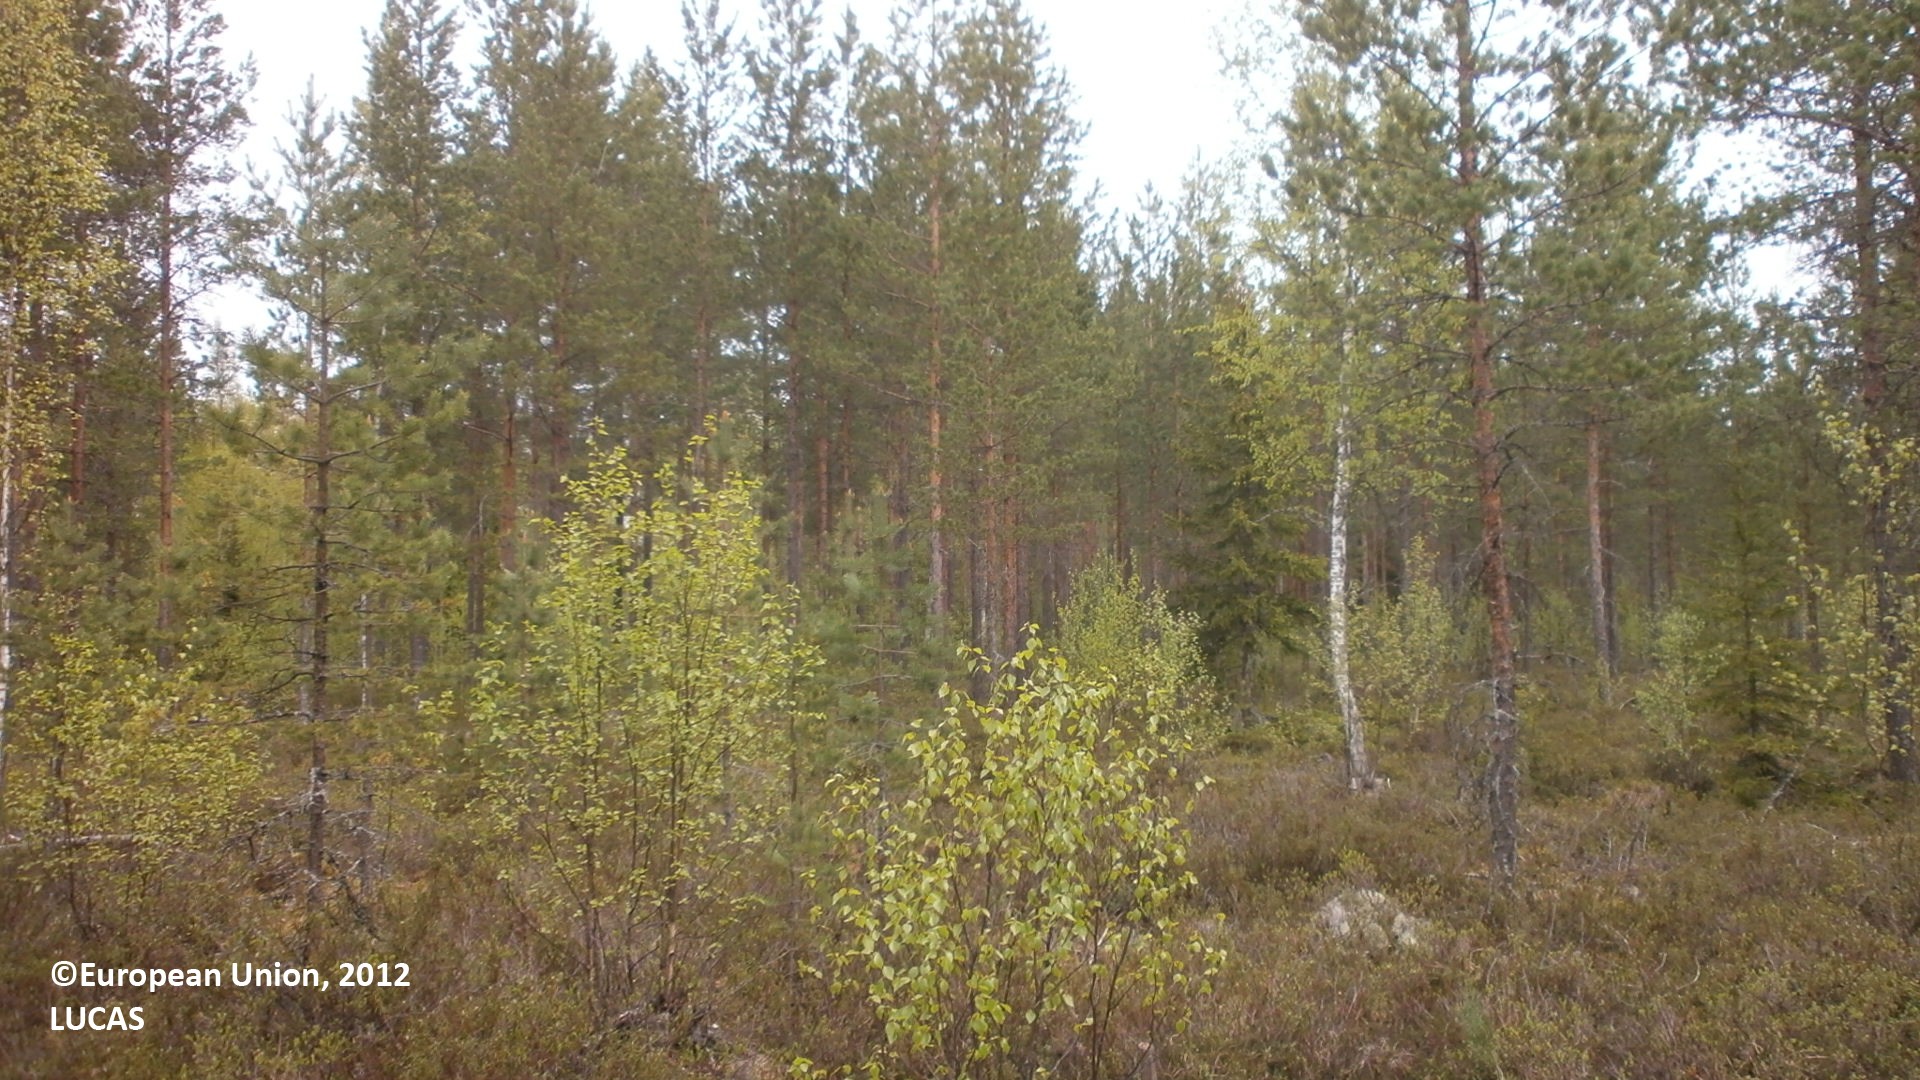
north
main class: Woodland
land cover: Pine dominated coniferous woodland
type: mire and swamp forests
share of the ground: 25 - 50 %
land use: Forestry
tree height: > 5 m
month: June
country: FI
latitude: 64.3169
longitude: 25.8377
